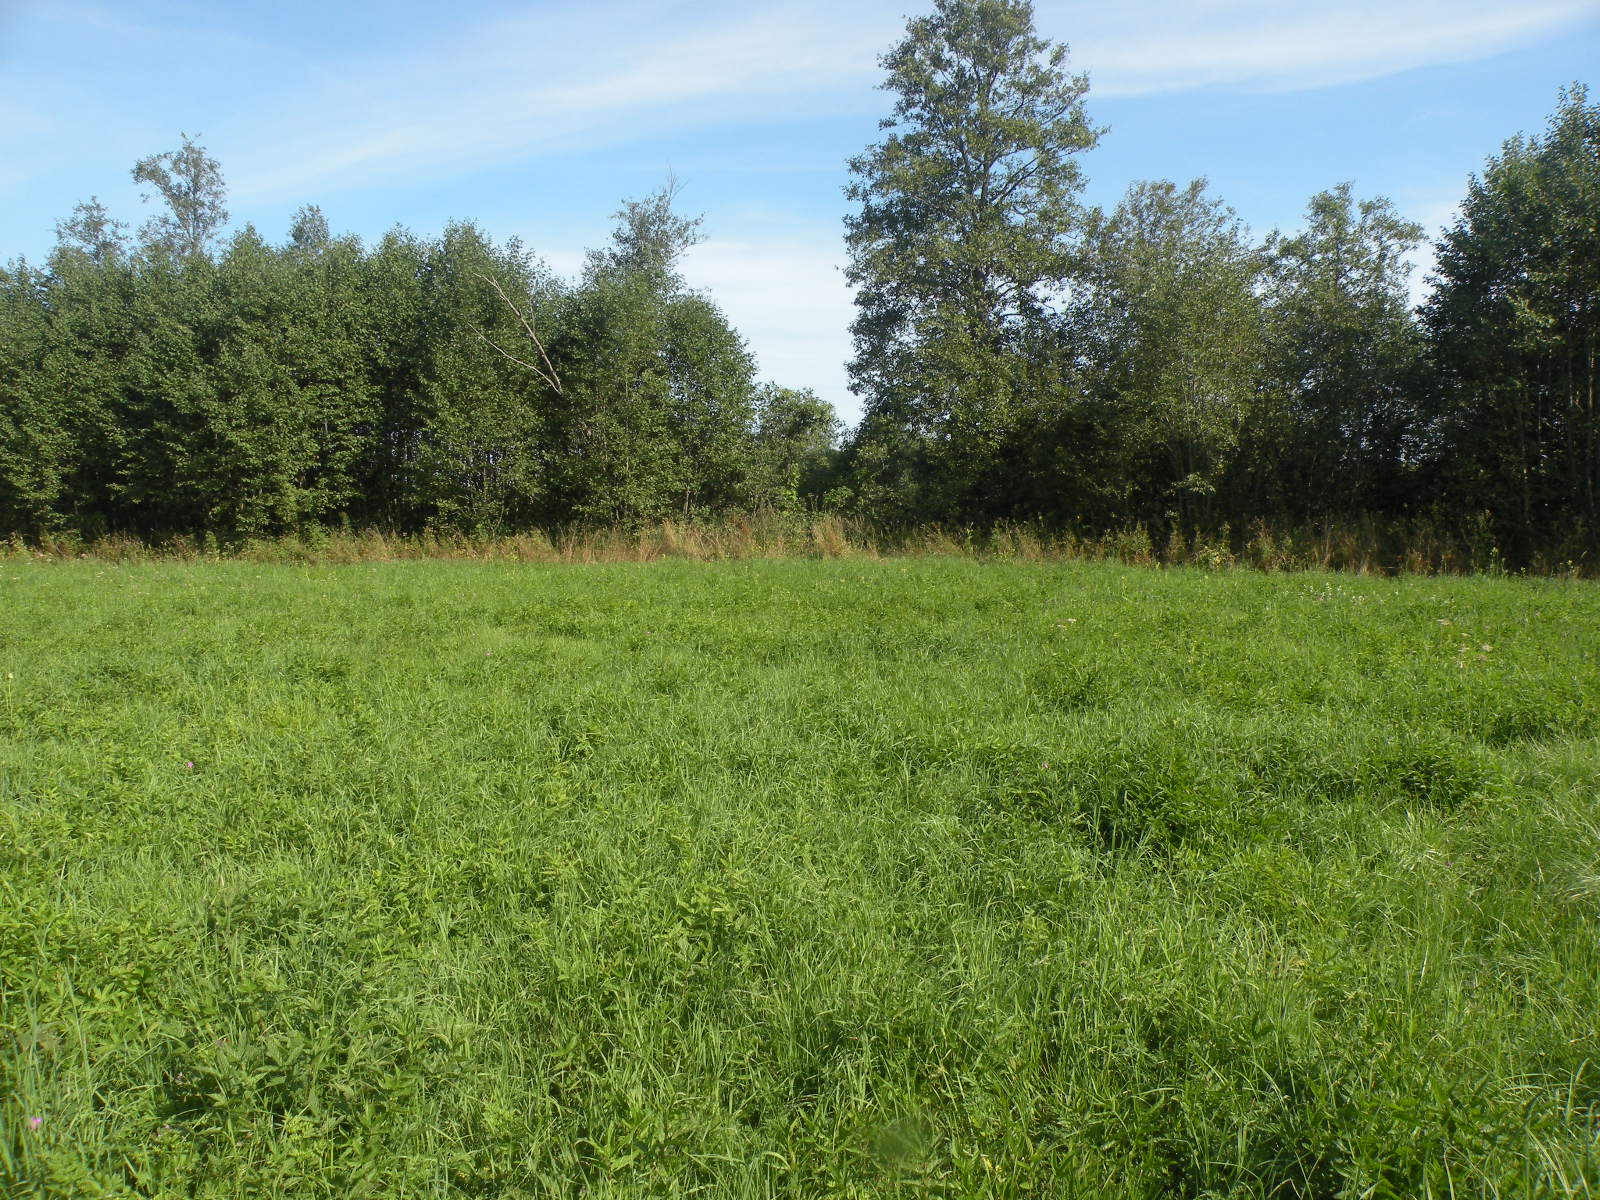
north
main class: Grassland
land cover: Grassland without tree/shrub cover
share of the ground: > 75 %
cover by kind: herbaceous plants 100 %
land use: Agriculture (excluding fallow land and kitchen gardens)
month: August
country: LV
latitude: 55.9481
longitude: 26.2690
